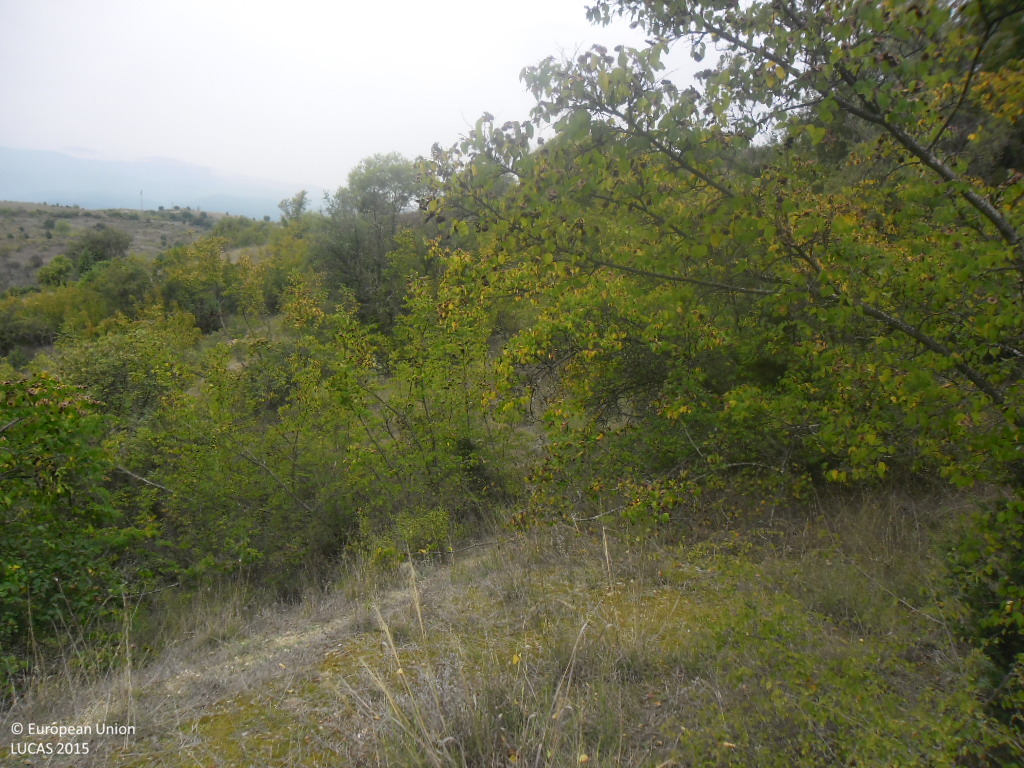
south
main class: Shrubland
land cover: Shrubland with sparse tree cover
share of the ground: 50 - 75 %
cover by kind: shrubs 70 %, herbaceous plants 25 %, broadleaved forest trees 5 %
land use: Semi-natural and natural areas not in use
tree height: < 5 m
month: October
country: BG
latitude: 41.3960
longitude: 23.3810
